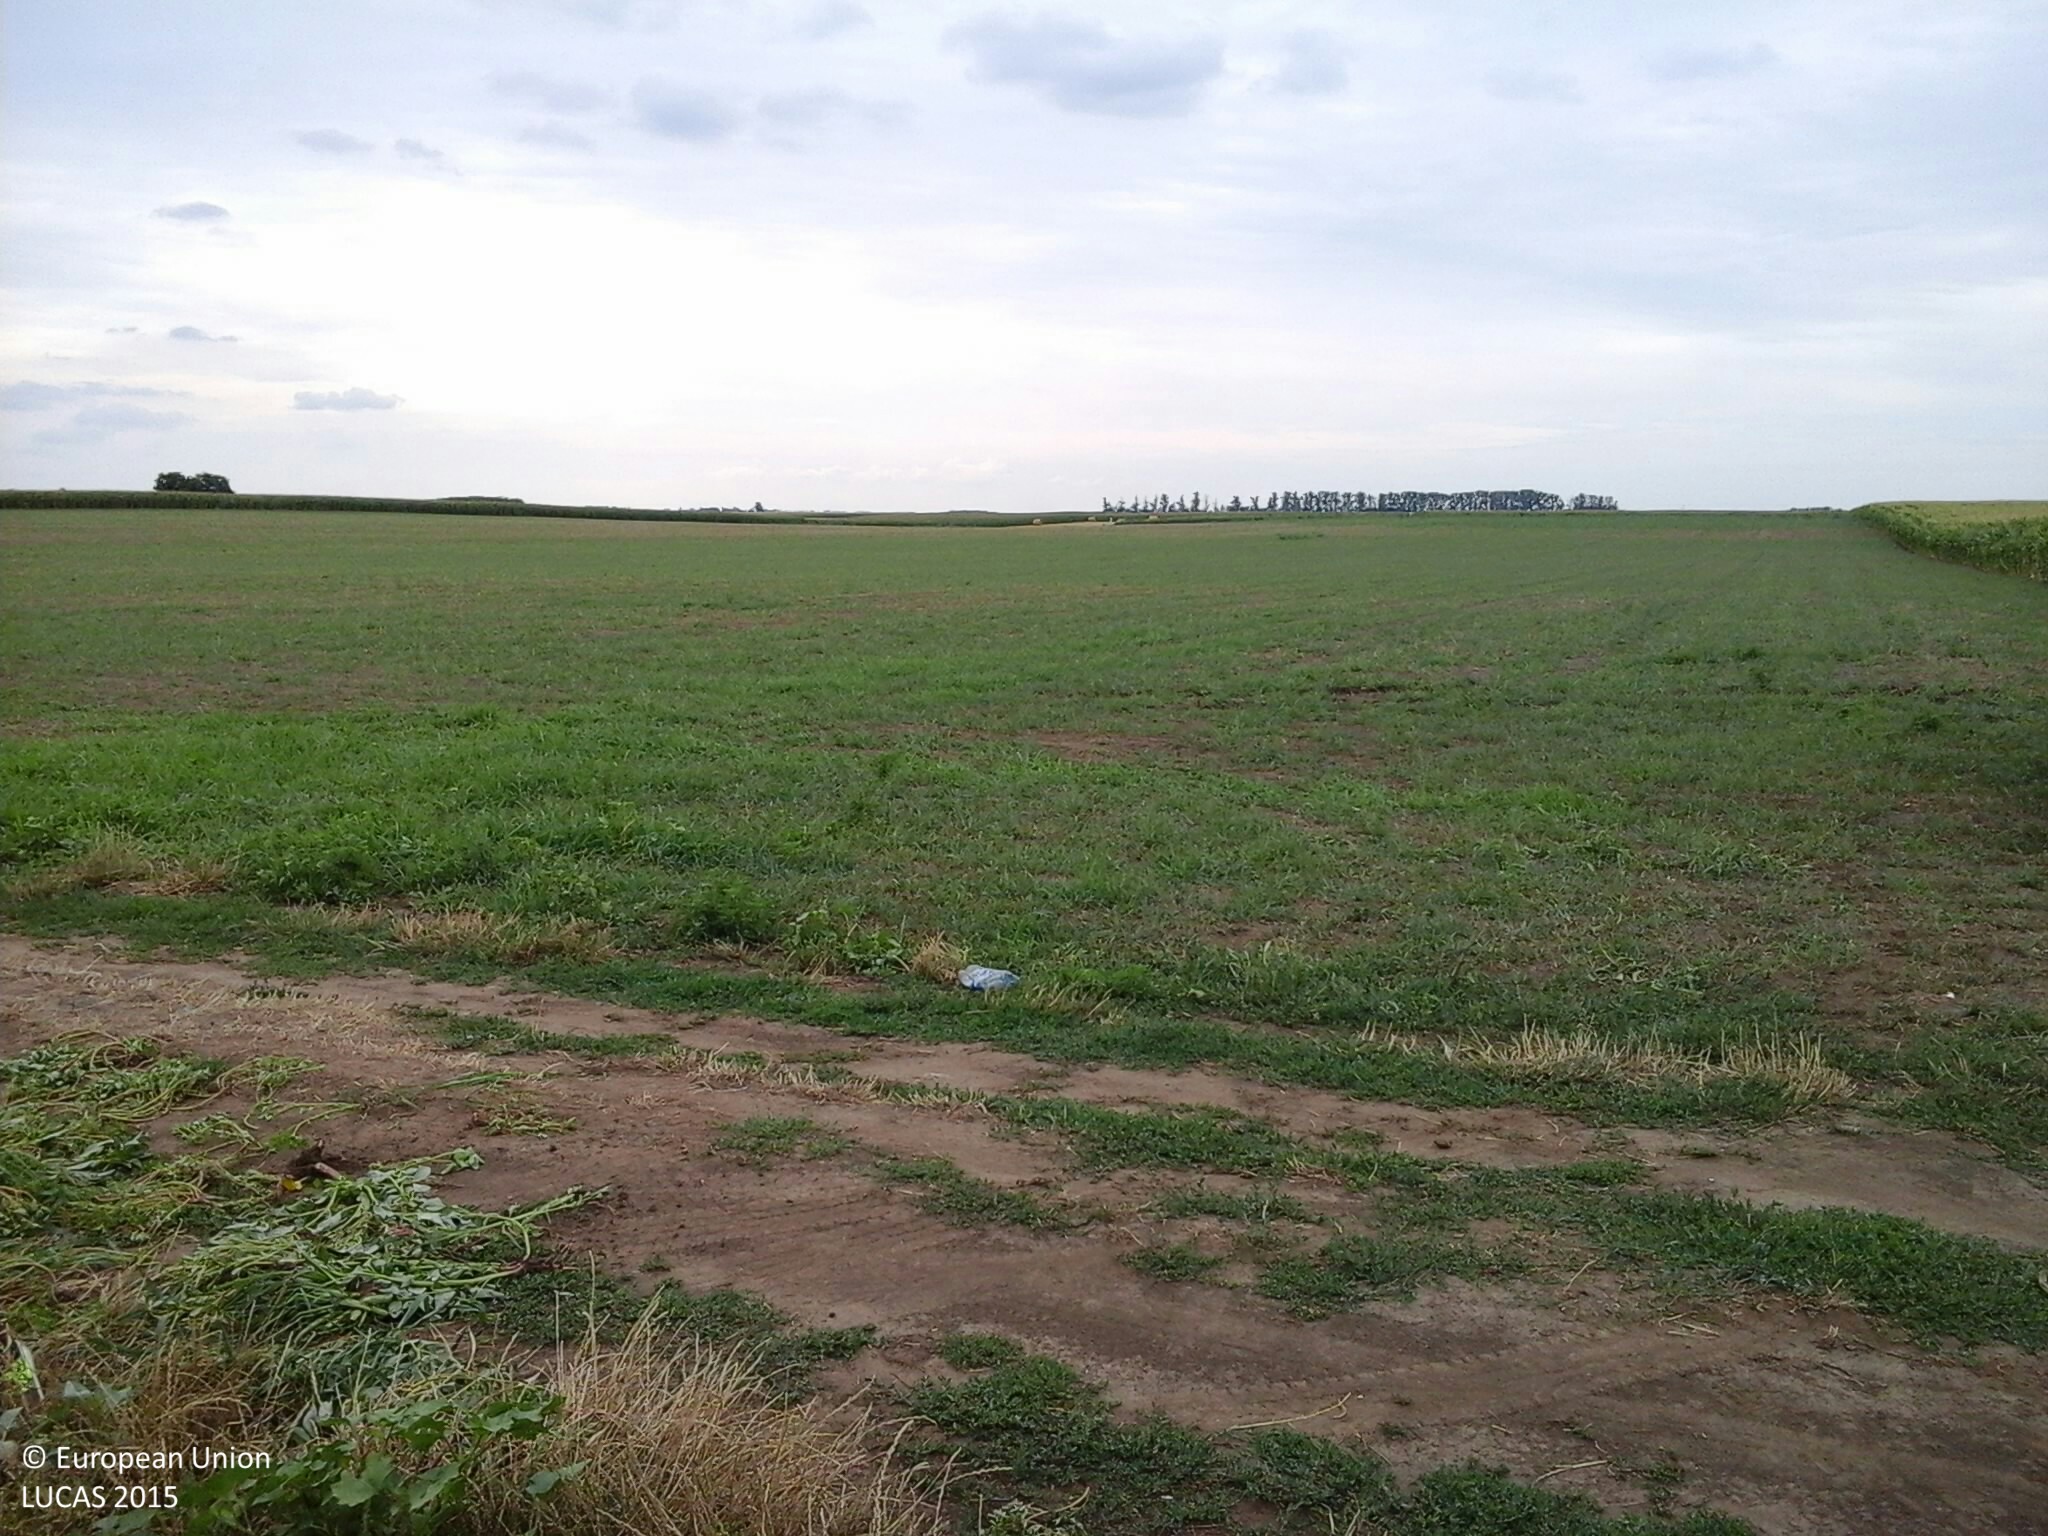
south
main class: Cropland
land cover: Maize
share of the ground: > 75 %
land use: Agriculture (excluding fallow land and kitchen gardens)
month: July
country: HU
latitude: 47.8054
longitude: 21.4602
